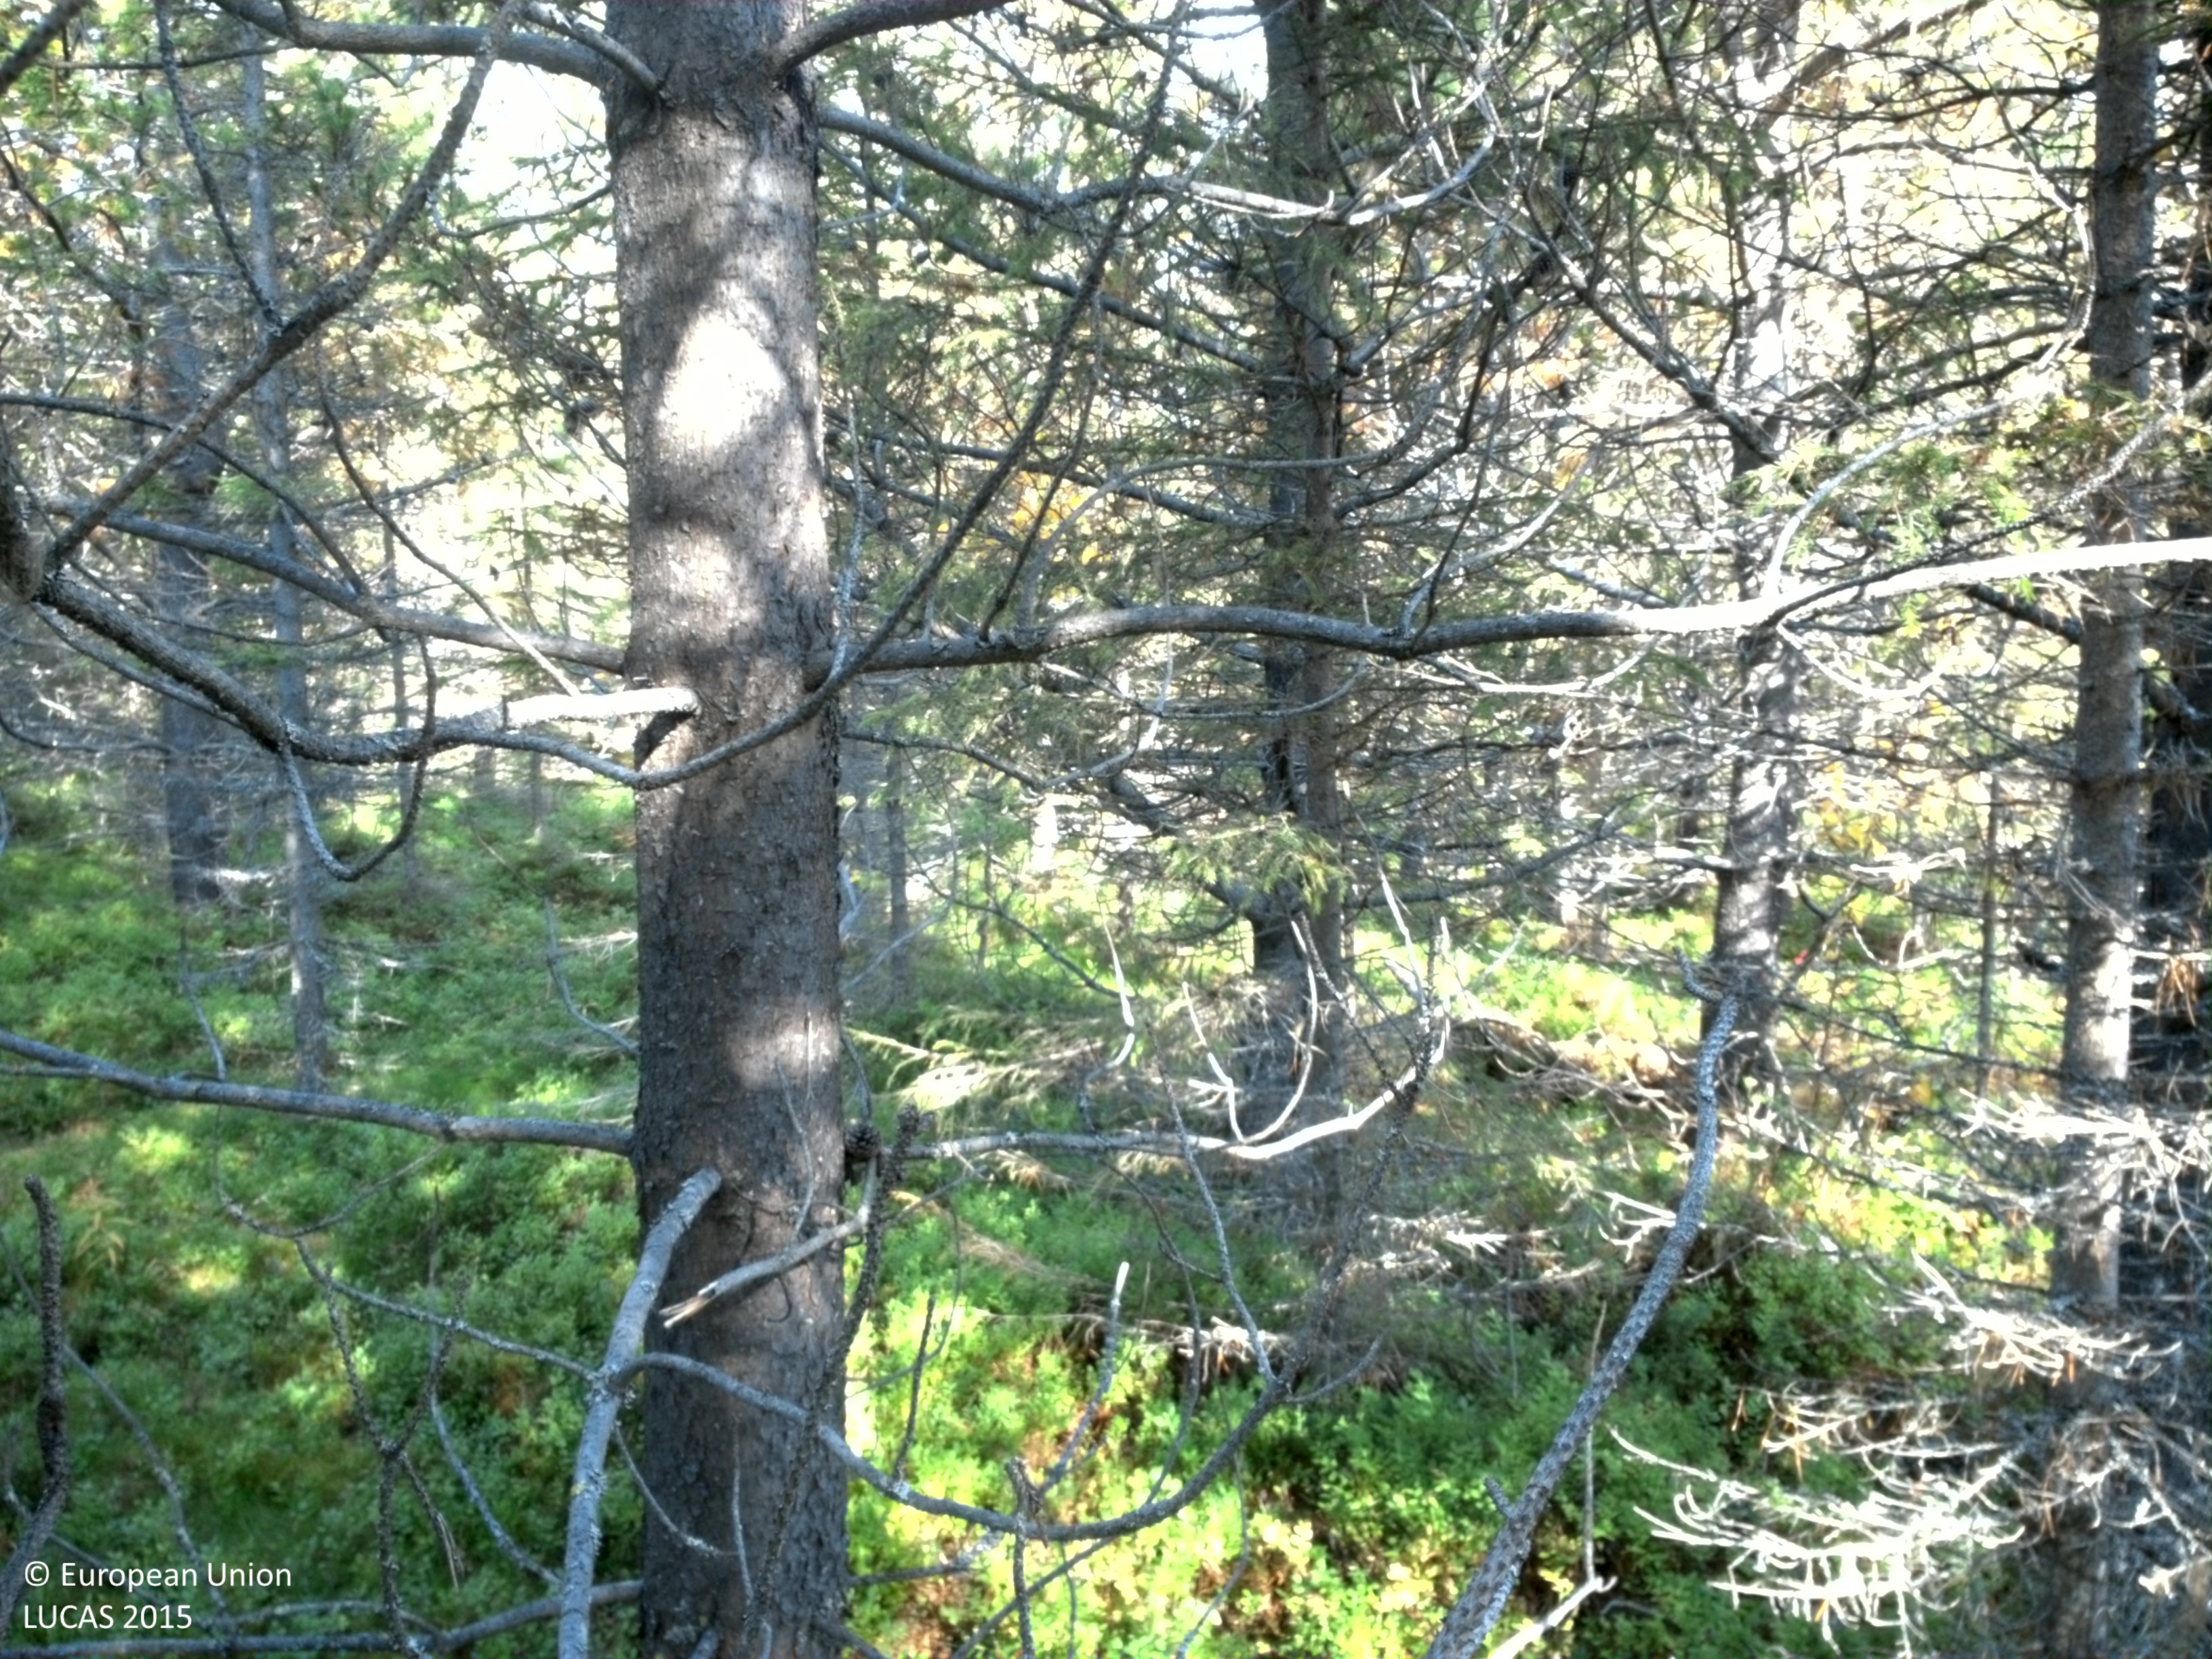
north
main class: Woodland
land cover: Pine dominated coniferous woodland
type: exotic forest
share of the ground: 50 - 75 %
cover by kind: coniferous forest trees 55 %, shrubs 30 %, broadleaved forest trees 5 %, herbaceous plants 5 %, lichens and mosses 5 %
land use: Forestry
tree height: > 5 m
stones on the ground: < 10 %
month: September
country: SE
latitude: 65.1212
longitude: 16.8442
